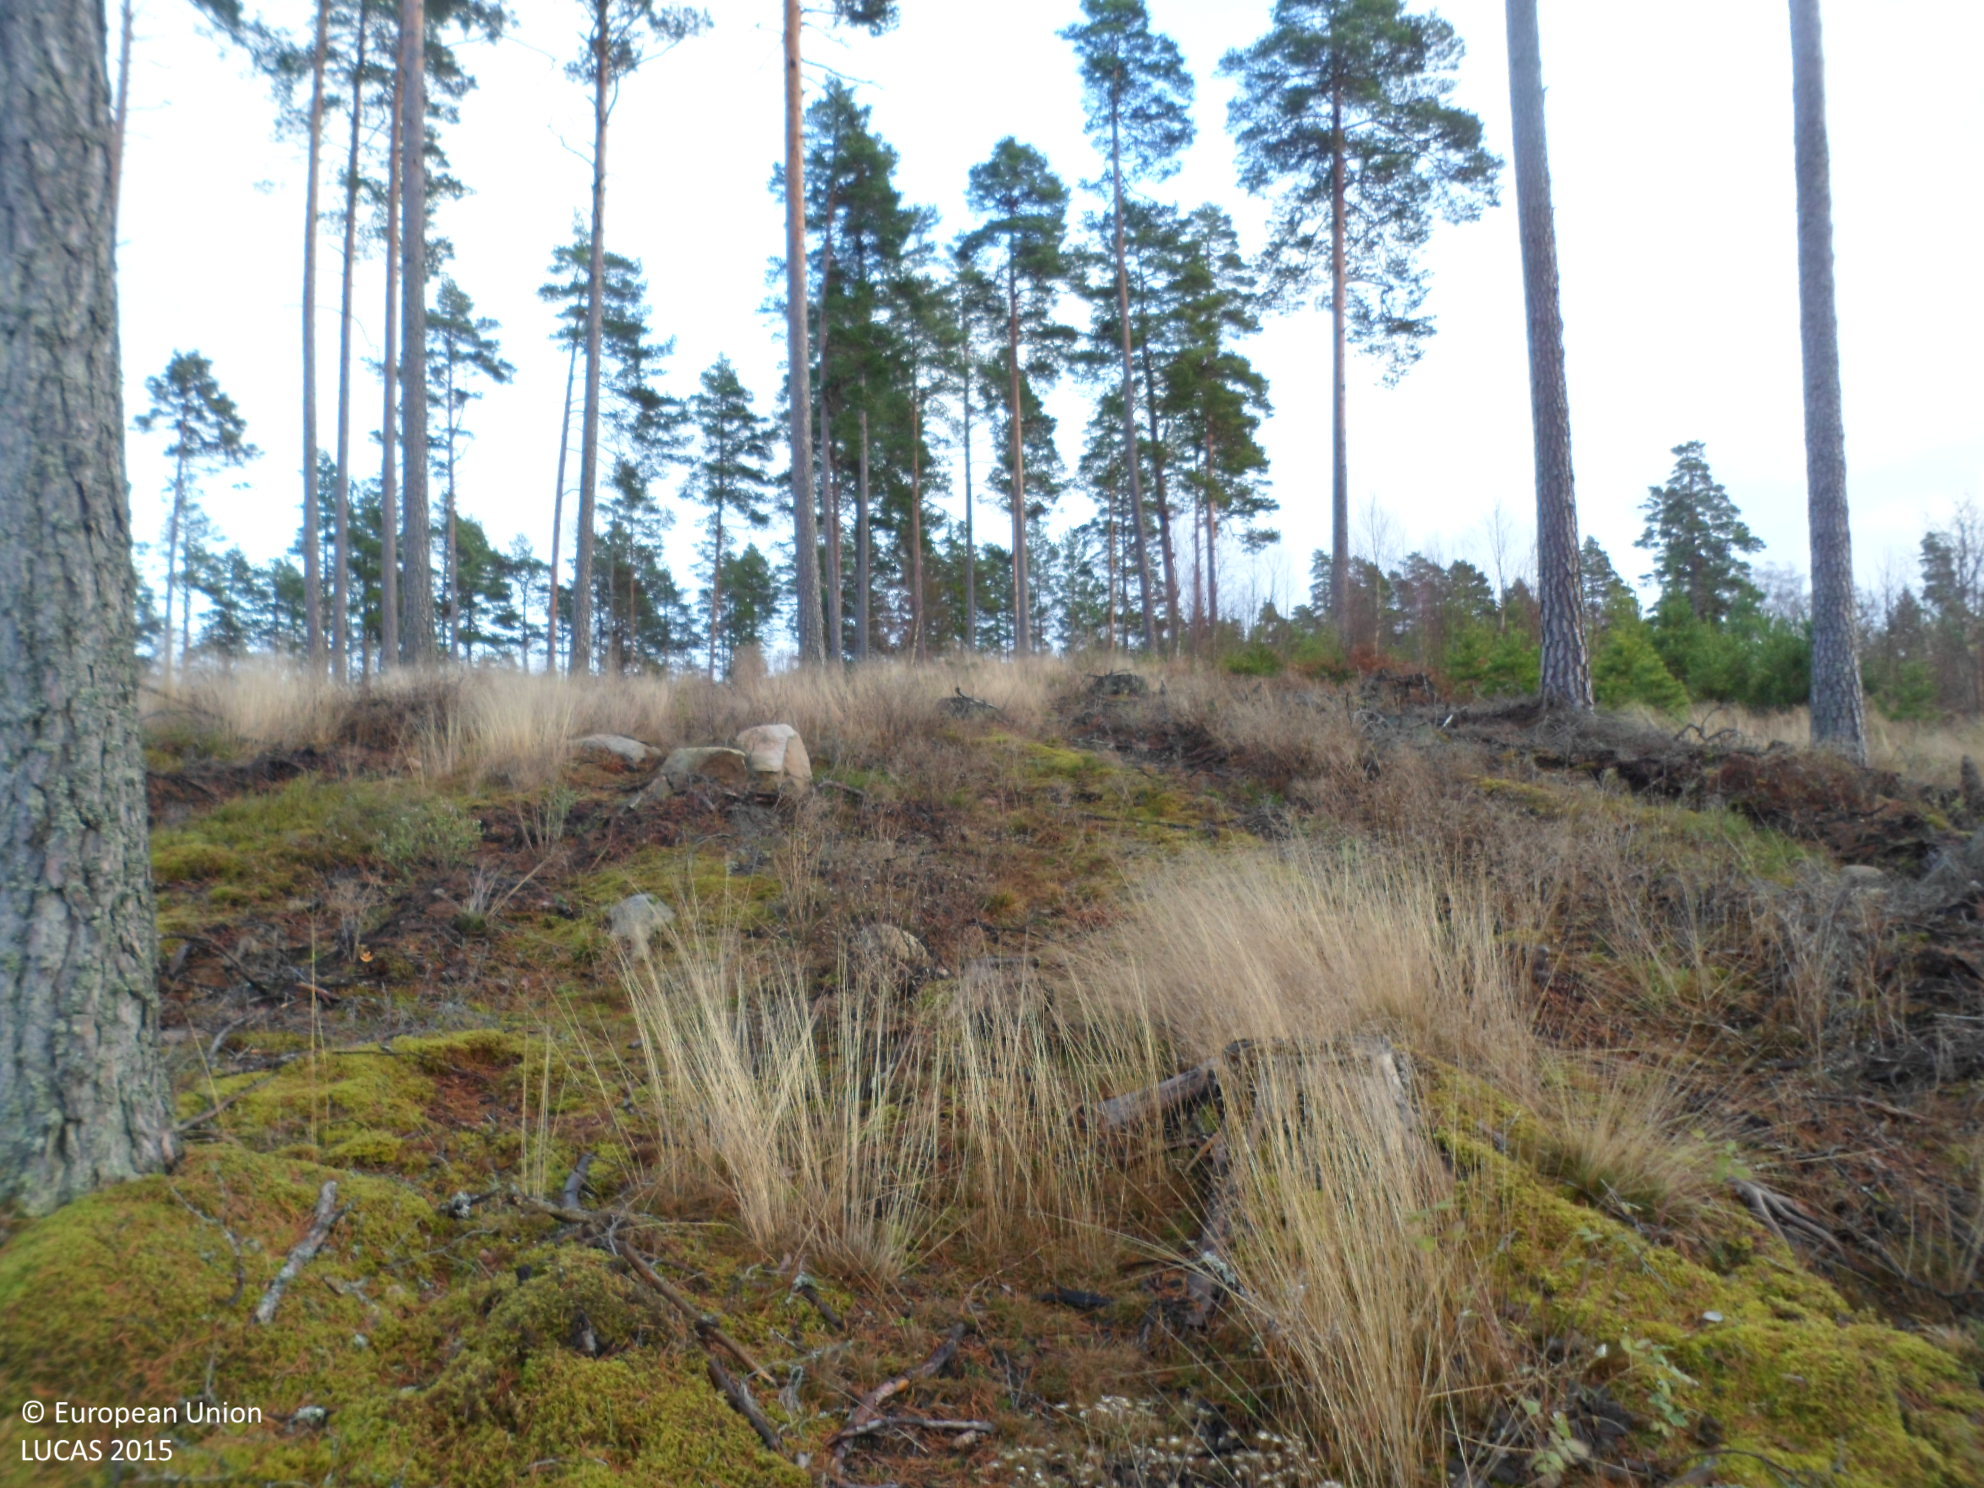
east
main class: Woodland
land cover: Pine dominated coniferous woodland
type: boreal forest
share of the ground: 25 - 50 %
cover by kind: coniferous forest trees 30 %, lichens and mosses 30 %, herbaceous plants 25 %, unconsolidated bare surface 10 %, shrubs 5 %
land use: Forestry
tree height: > 5 m
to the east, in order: Pine dominated coniferous woodland; Pine dominated mixed woodland; Pine dominated coniferous woodland; Spruce dominated mixed woodland
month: November
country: SE
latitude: 57.6213
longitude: 15.4713
